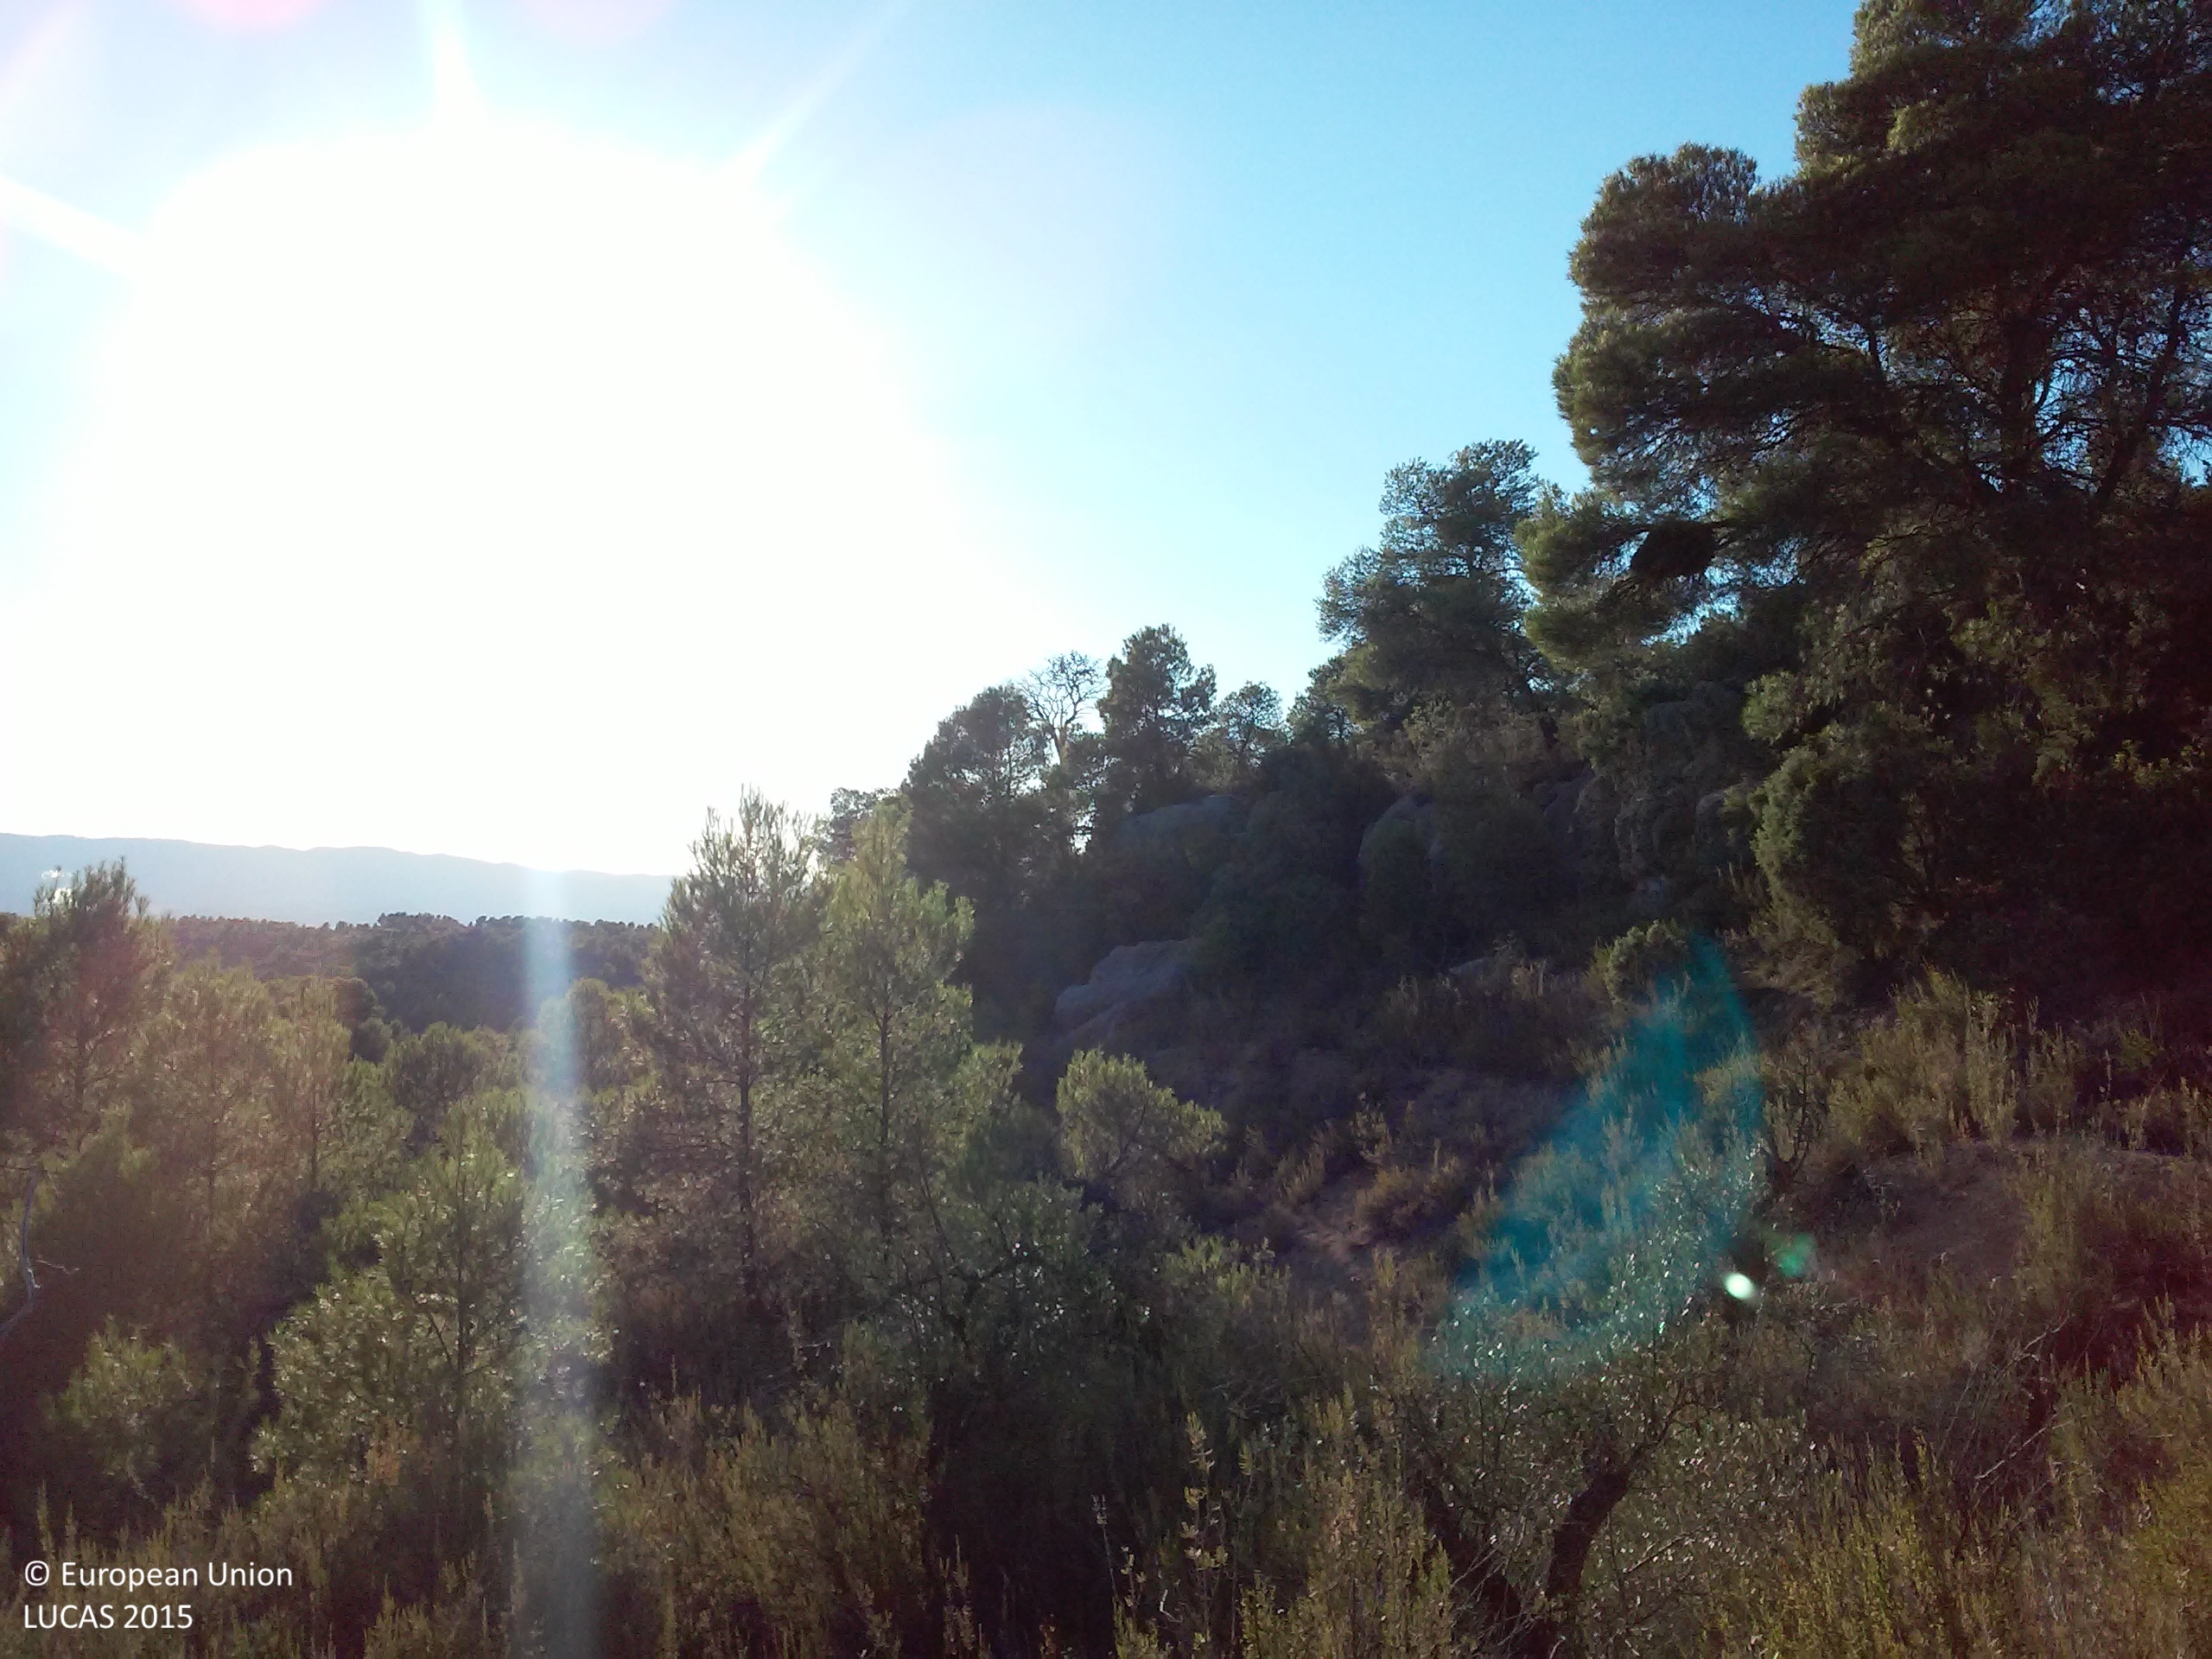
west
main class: Shrubland
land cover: Shrubland with sparse tree cover
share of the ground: 10 - 25 %
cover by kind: shrubs 50 %, consolidated bare surface 45 %, broadleaved forest trees 5 %
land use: Semi-natural and natural areas not in use
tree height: < 5 m
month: September
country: ES
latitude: 41.2210
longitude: 0.6510
